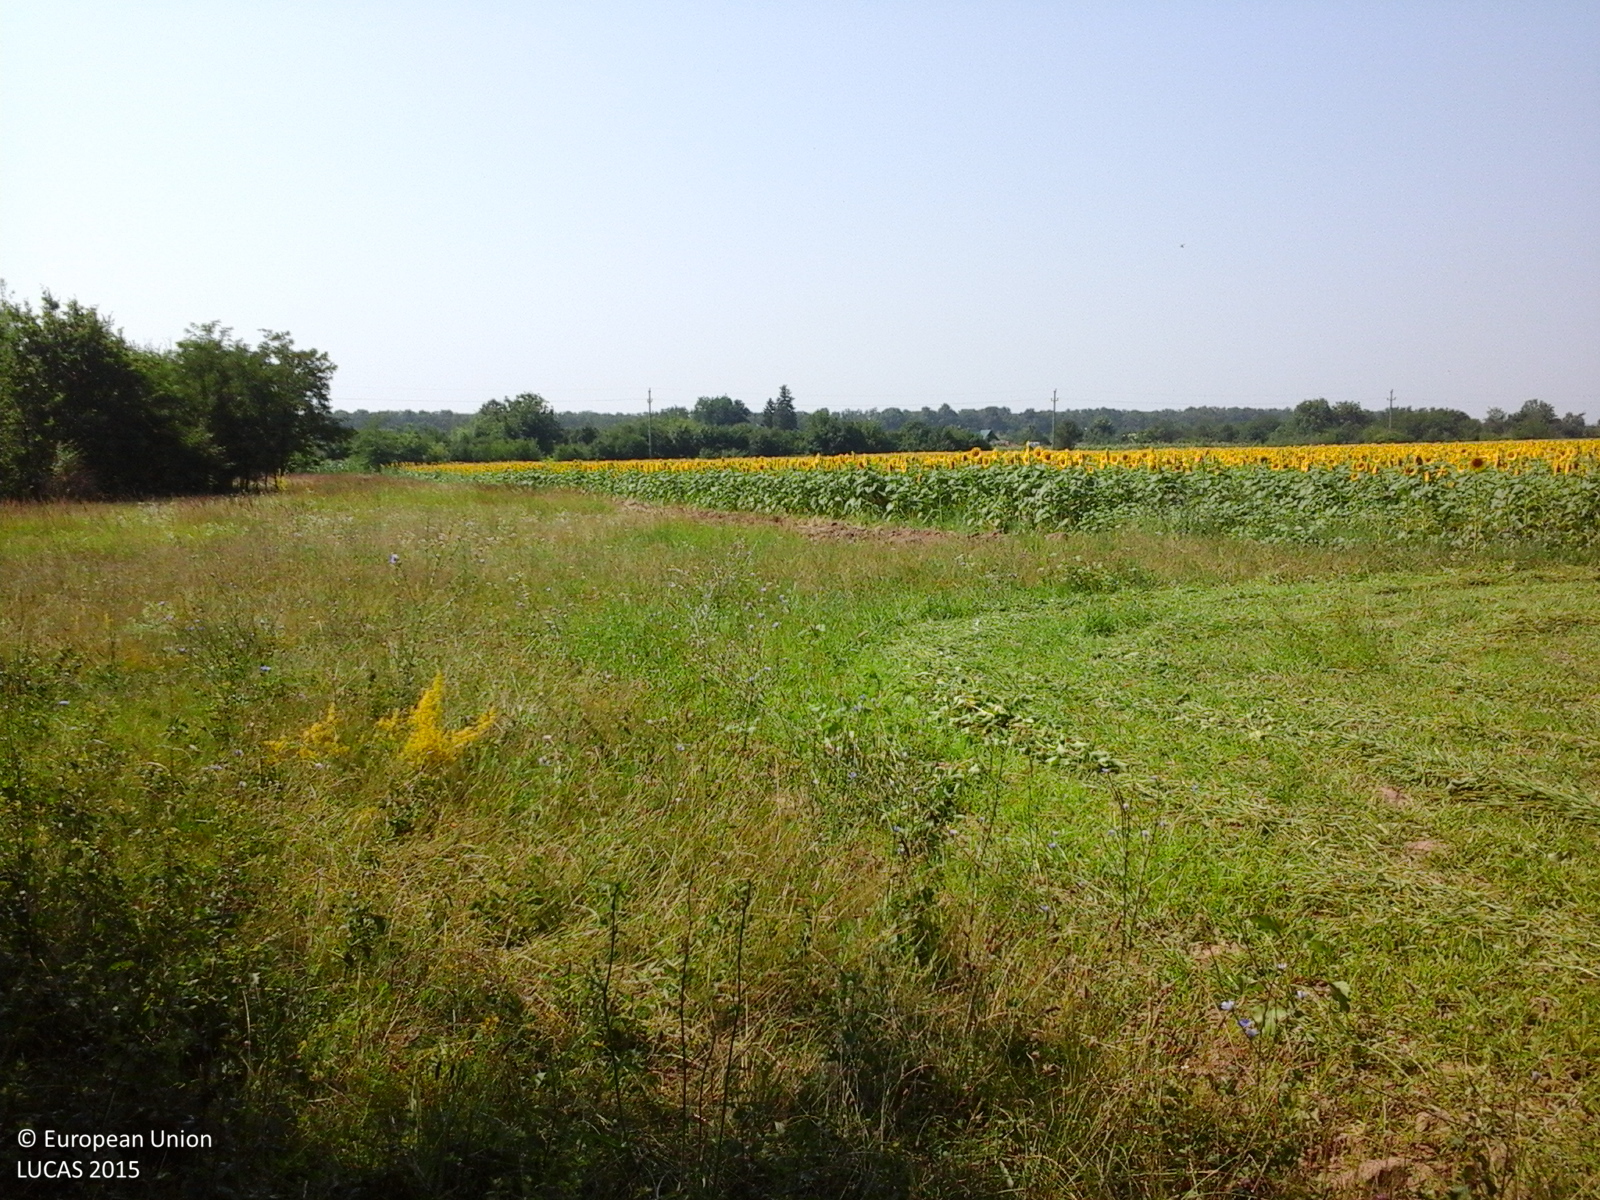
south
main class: Grassland
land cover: Grassland without tree/shrub cover
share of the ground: > 75 %
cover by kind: herbaceous plants 100 %
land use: Agriculture (excluding fallow land and kitchen gardens)
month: July
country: RO
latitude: 44.7155
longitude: 25.6365
